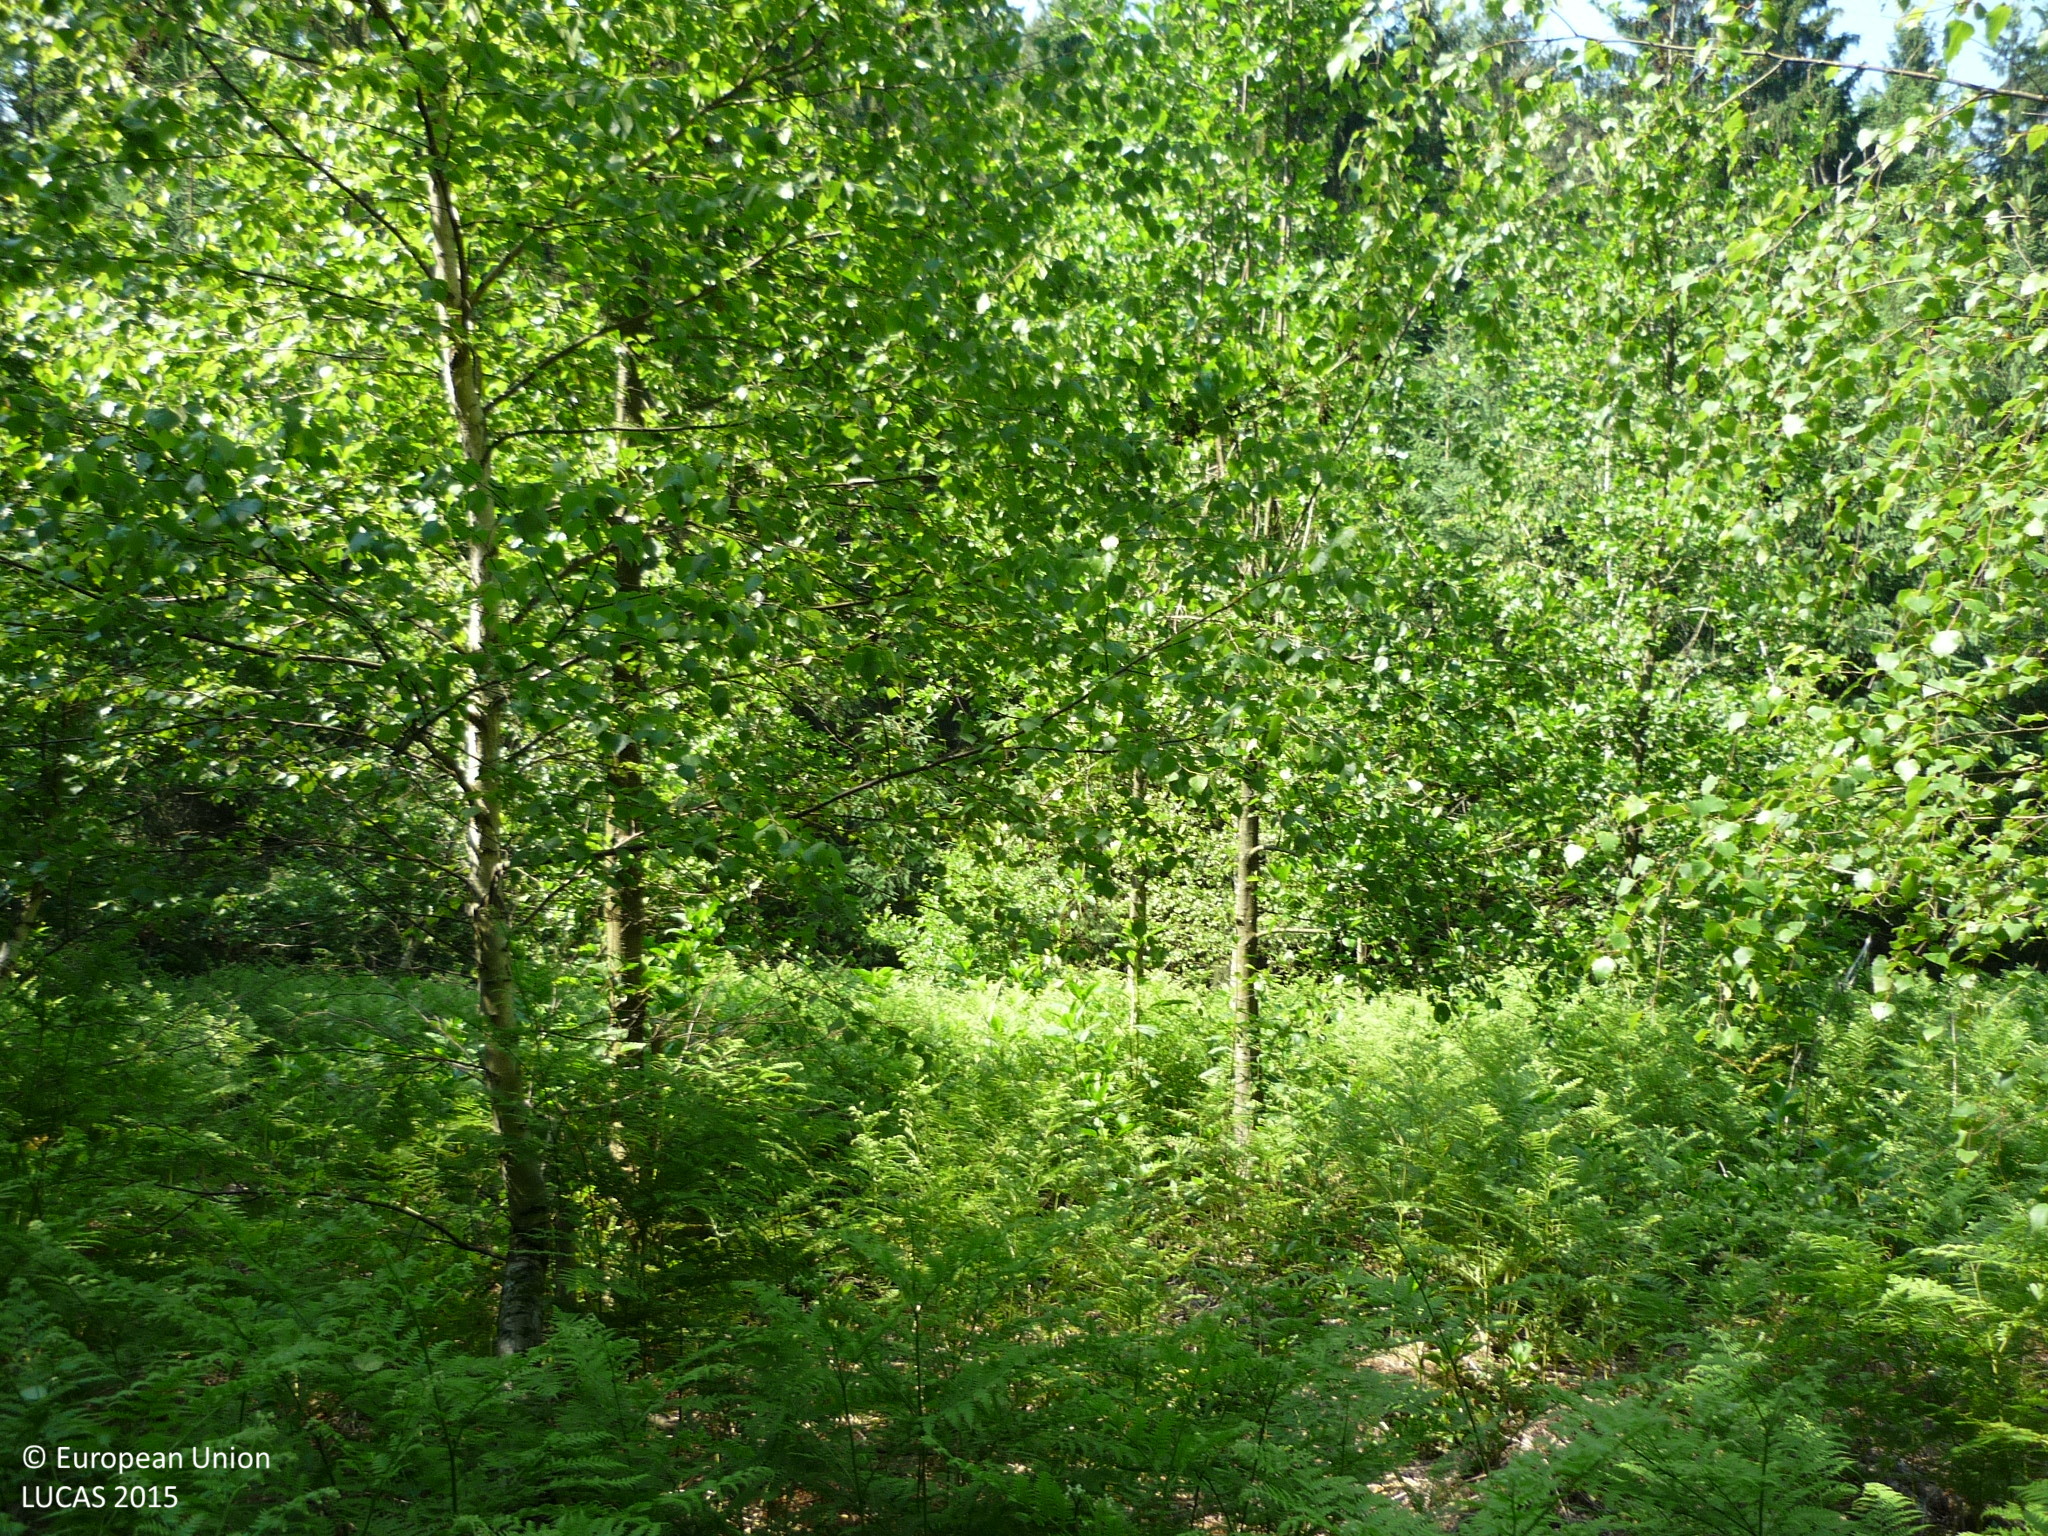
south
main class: Woodland
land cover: Broadleaved woodland
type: non-riverine alder, birch or aspen forest
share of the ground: > 75 %
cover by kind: broadleaved forest trees 50 %, herbaceous plants 40 %, unconsolidated bare surface 10 %
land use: Forestry
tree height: < 5 m
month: June
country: AT
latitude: 46.7771
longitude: 15.6969
